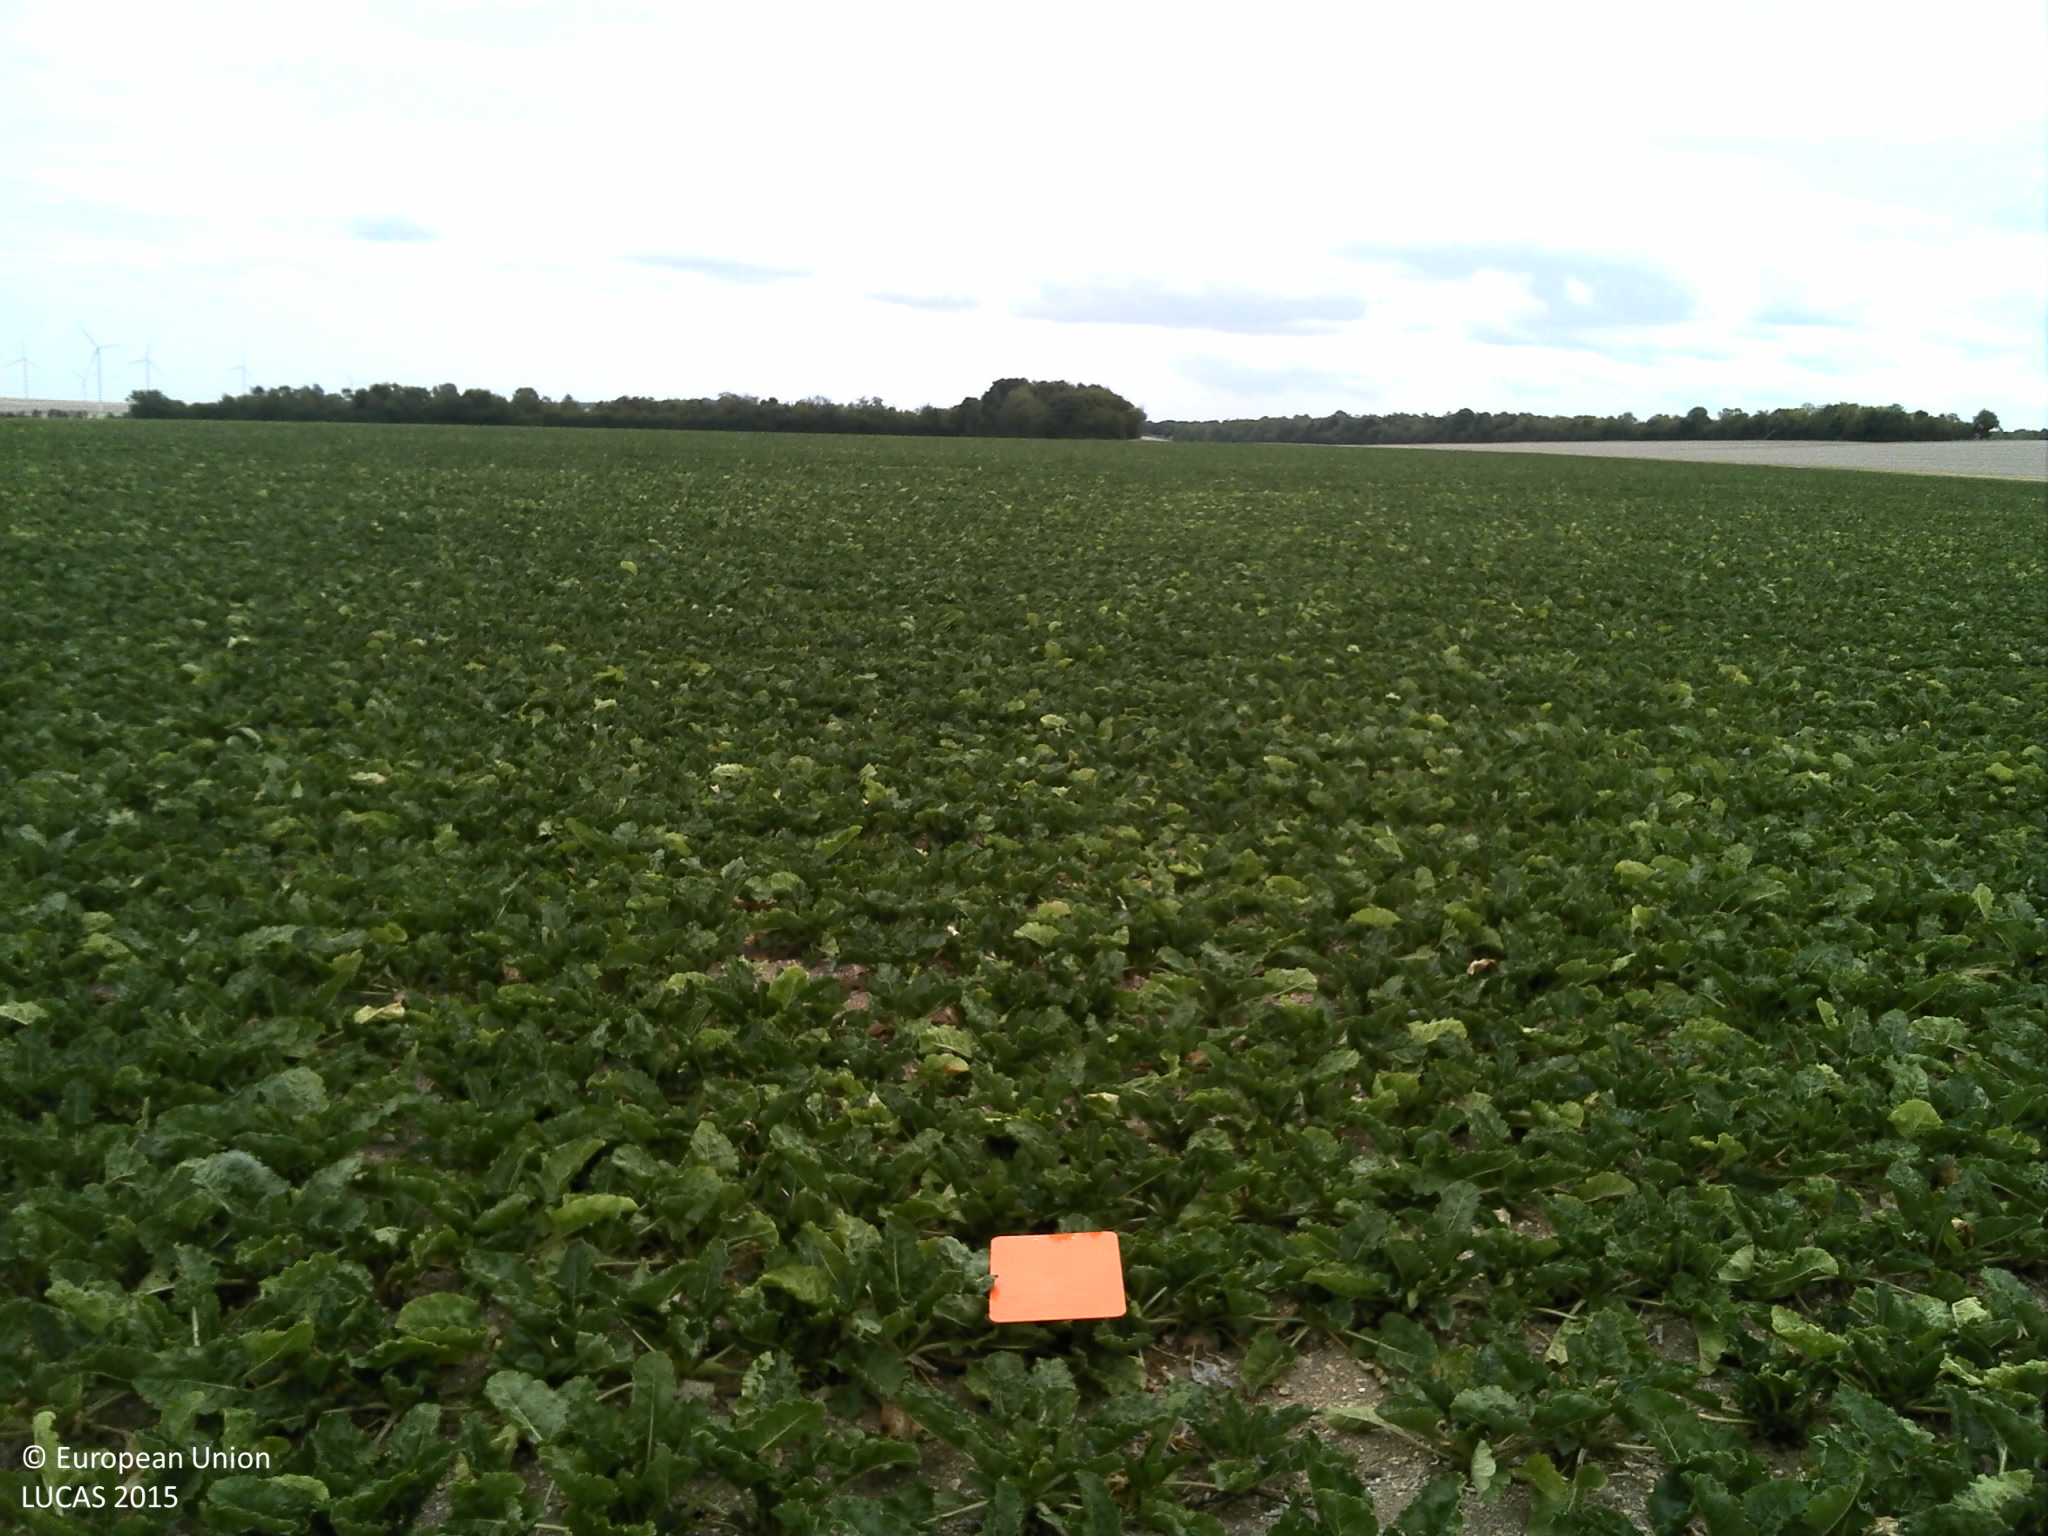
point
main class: Cropland
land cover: Sugar beet
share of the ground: > 75 %
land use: Agriculture (excluding fallow land and kitchen gardens)
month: August
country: FR
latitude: 48.4660
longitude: 4.1672
